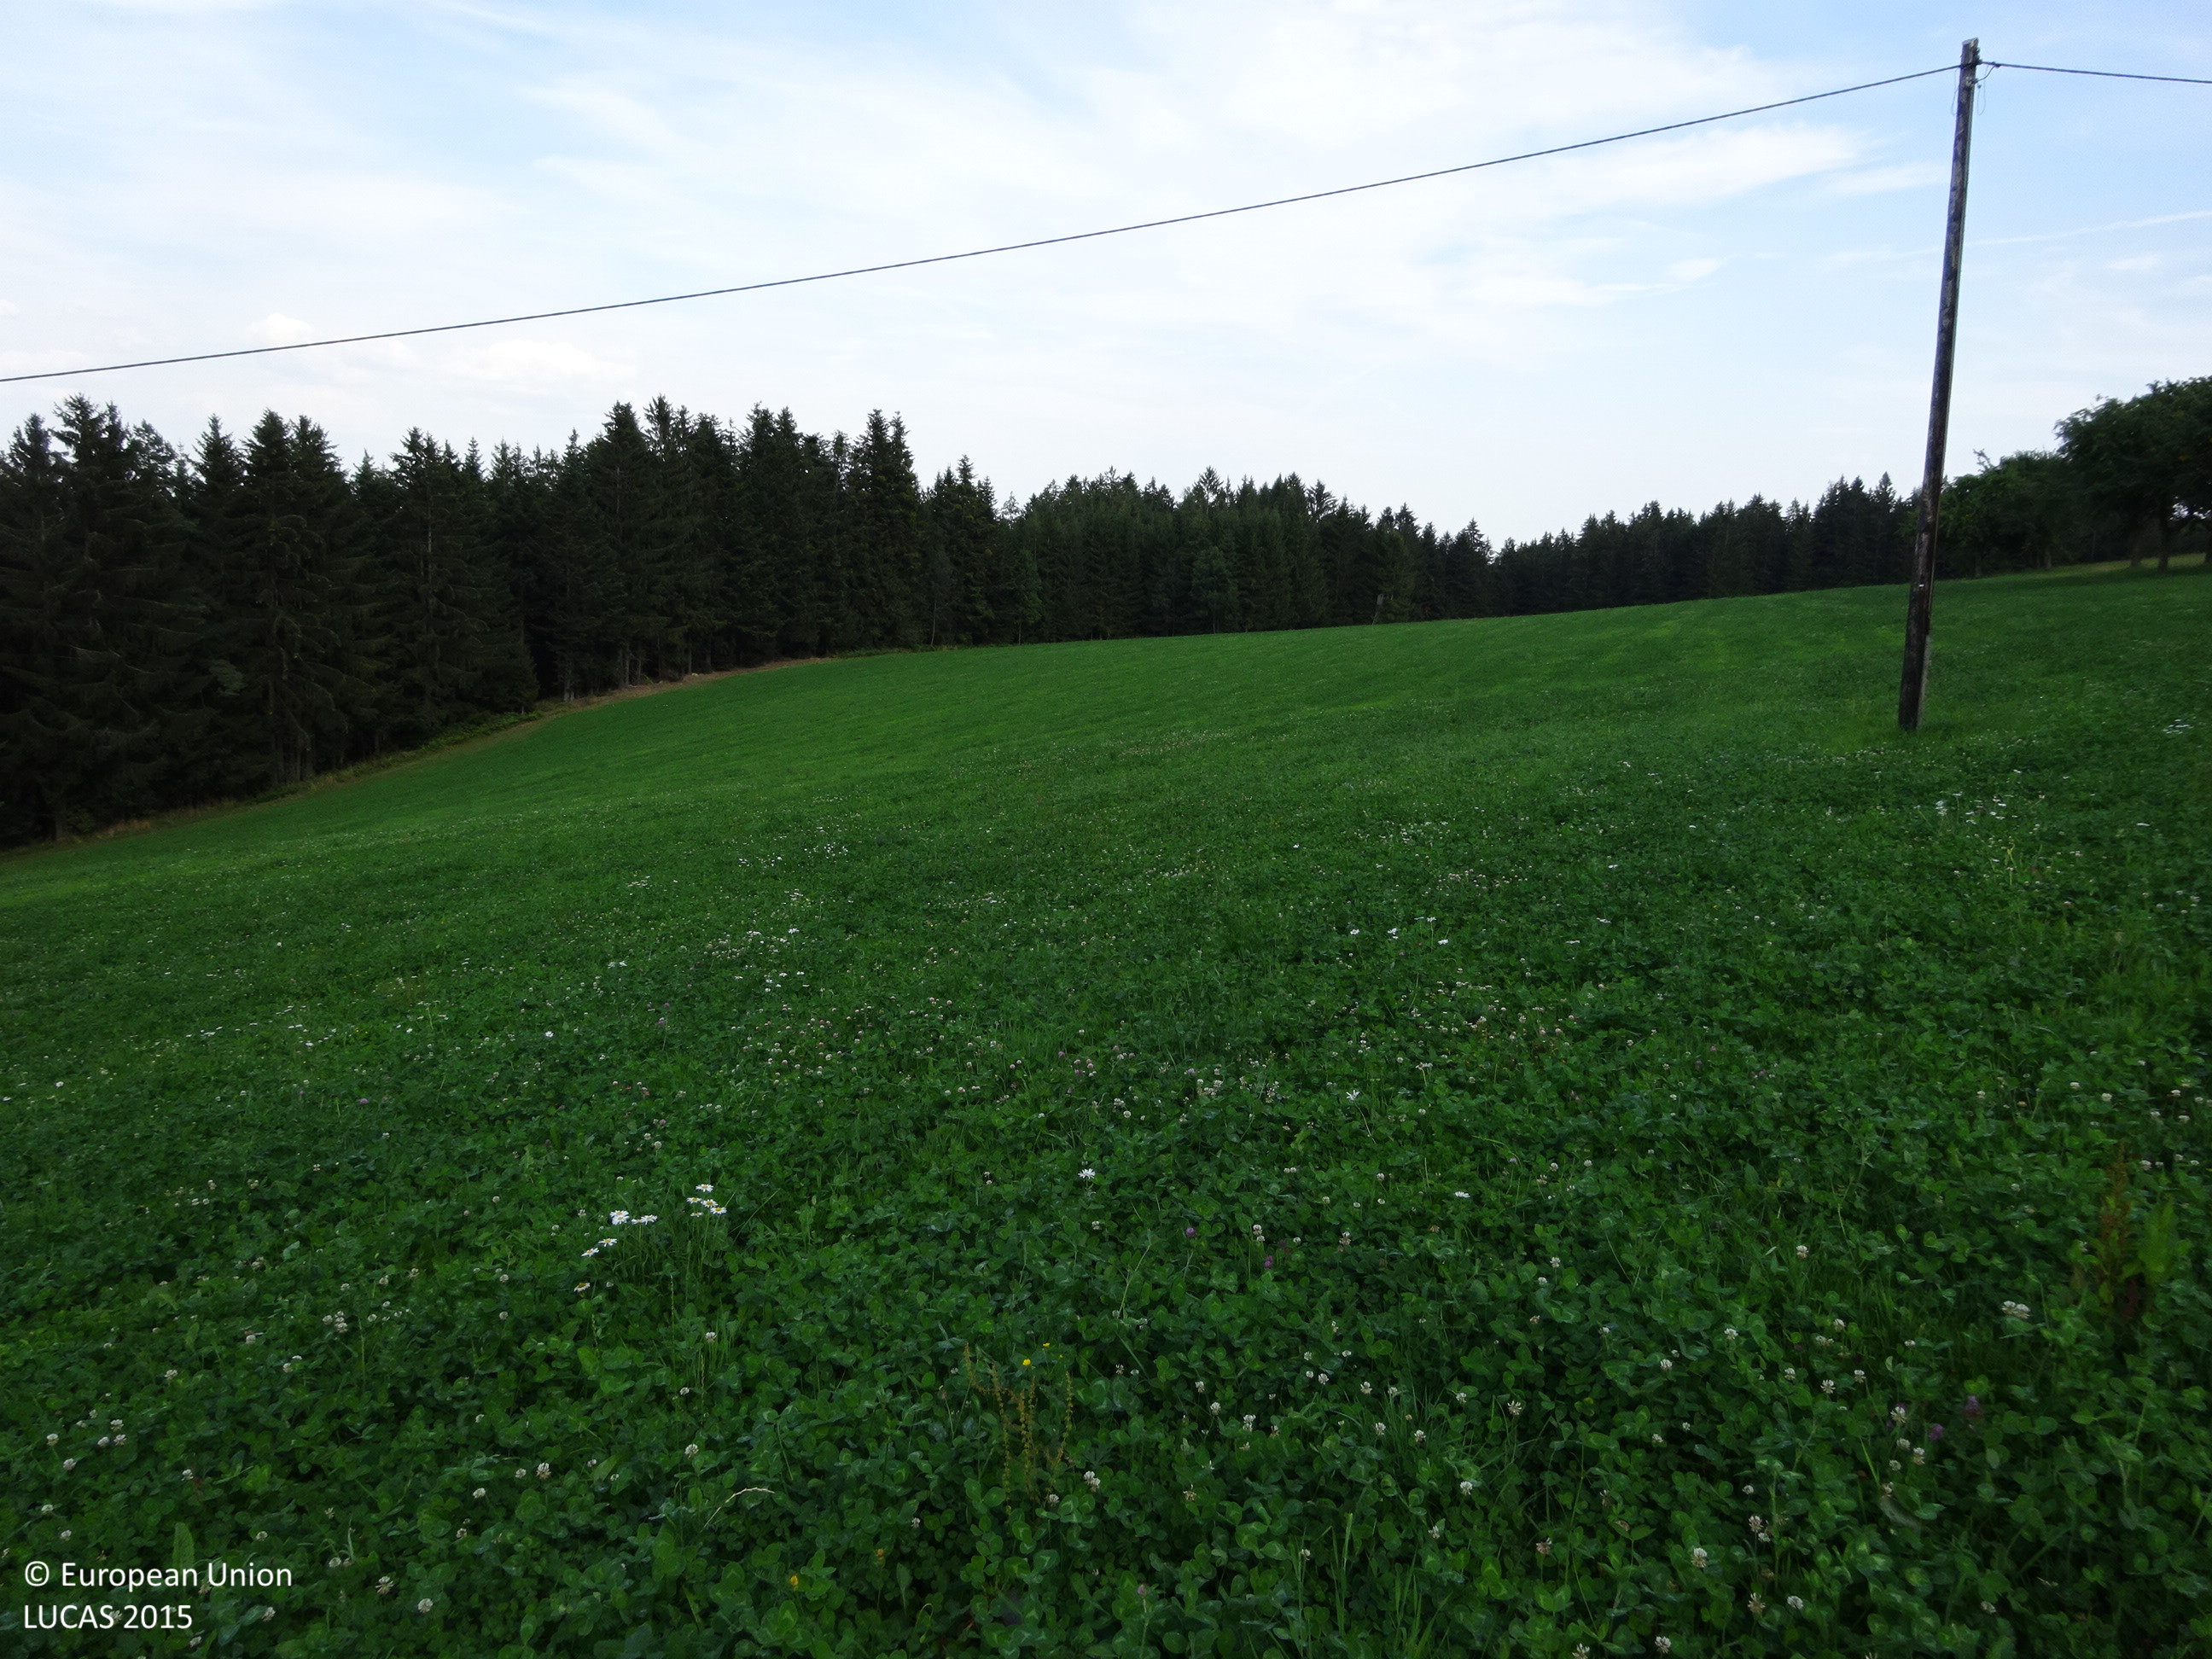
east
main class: Cropland
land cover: Clovers
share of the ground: > 75 %
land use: Agriculture (excluding fallow land and kitchen gardens)
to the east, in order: Clovers; Electric lines; Clovers; Grassland without tree/shrub cover; Spruce dominated coniferous woodland
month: August
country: AT
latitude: 47.4230
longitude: 15.7677
